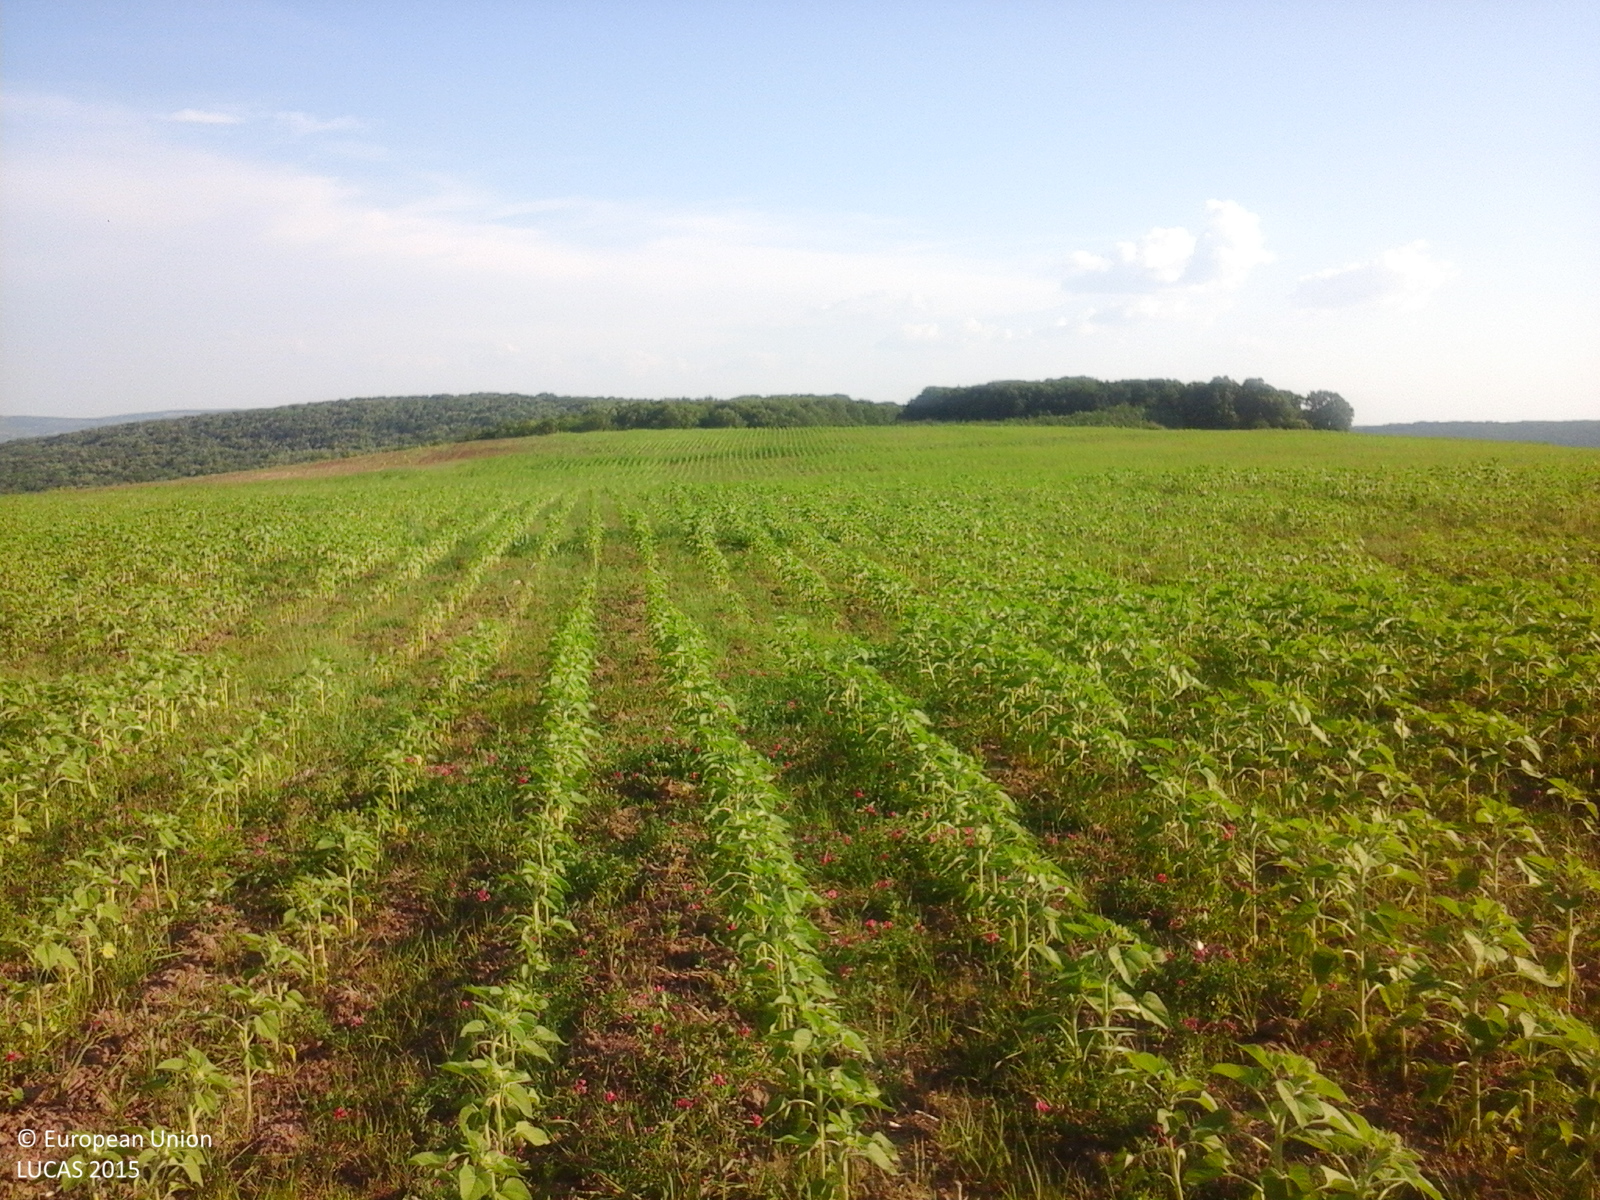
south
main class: Cropland
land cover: Sunflower
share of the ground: 50 - 75 %
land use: Agriculture (excluding fallow land and kitchen gardens)
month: June
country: RO
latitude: 46.7402
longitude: 28.0203
